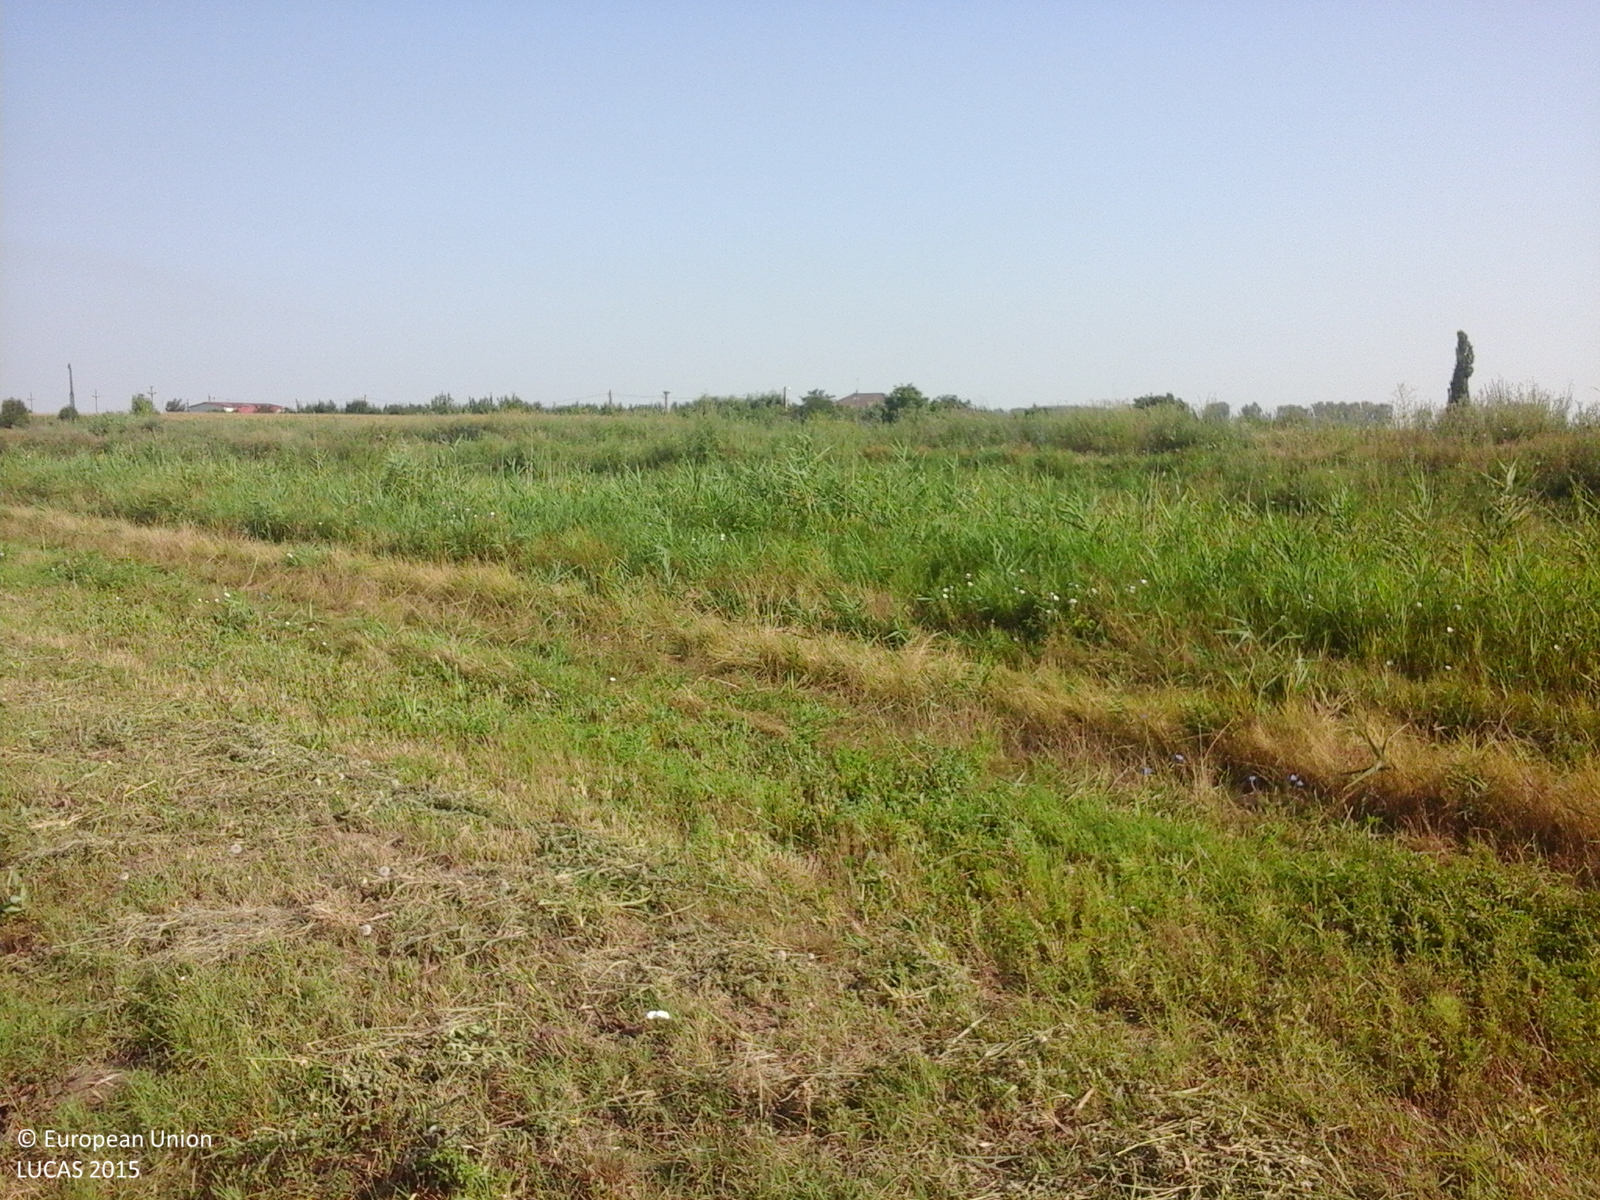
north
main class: Cropland
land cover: Lucerne
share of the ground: > 75 %
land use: Agriculture (excluding fallow land and kitchen gardens)
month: July
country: RO
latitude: 44.1890
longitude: 26.8738
